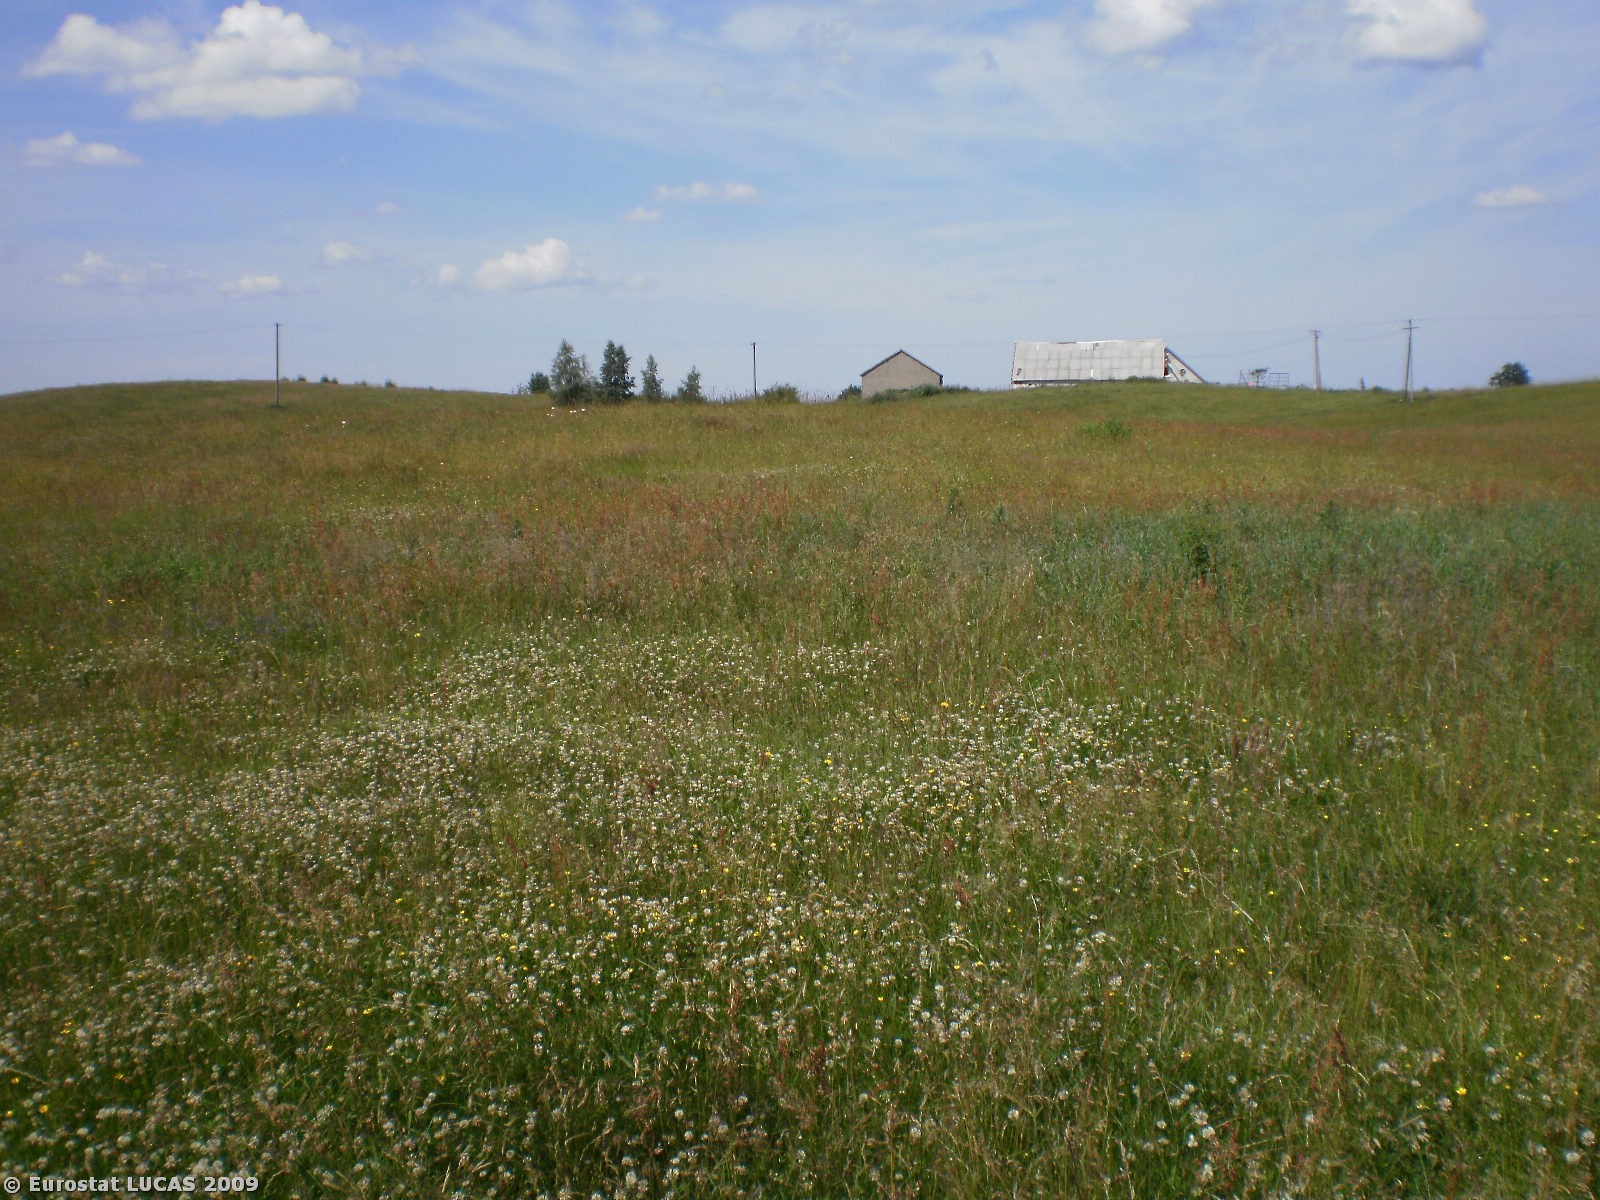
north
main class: Grassland
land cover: Grassland without tree/shrub cover
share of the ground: > 75 %
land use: Agriculture (excluding fallow land and kitchen gardens)
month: July
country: PL
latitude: 54.3160
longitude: 17.9301
